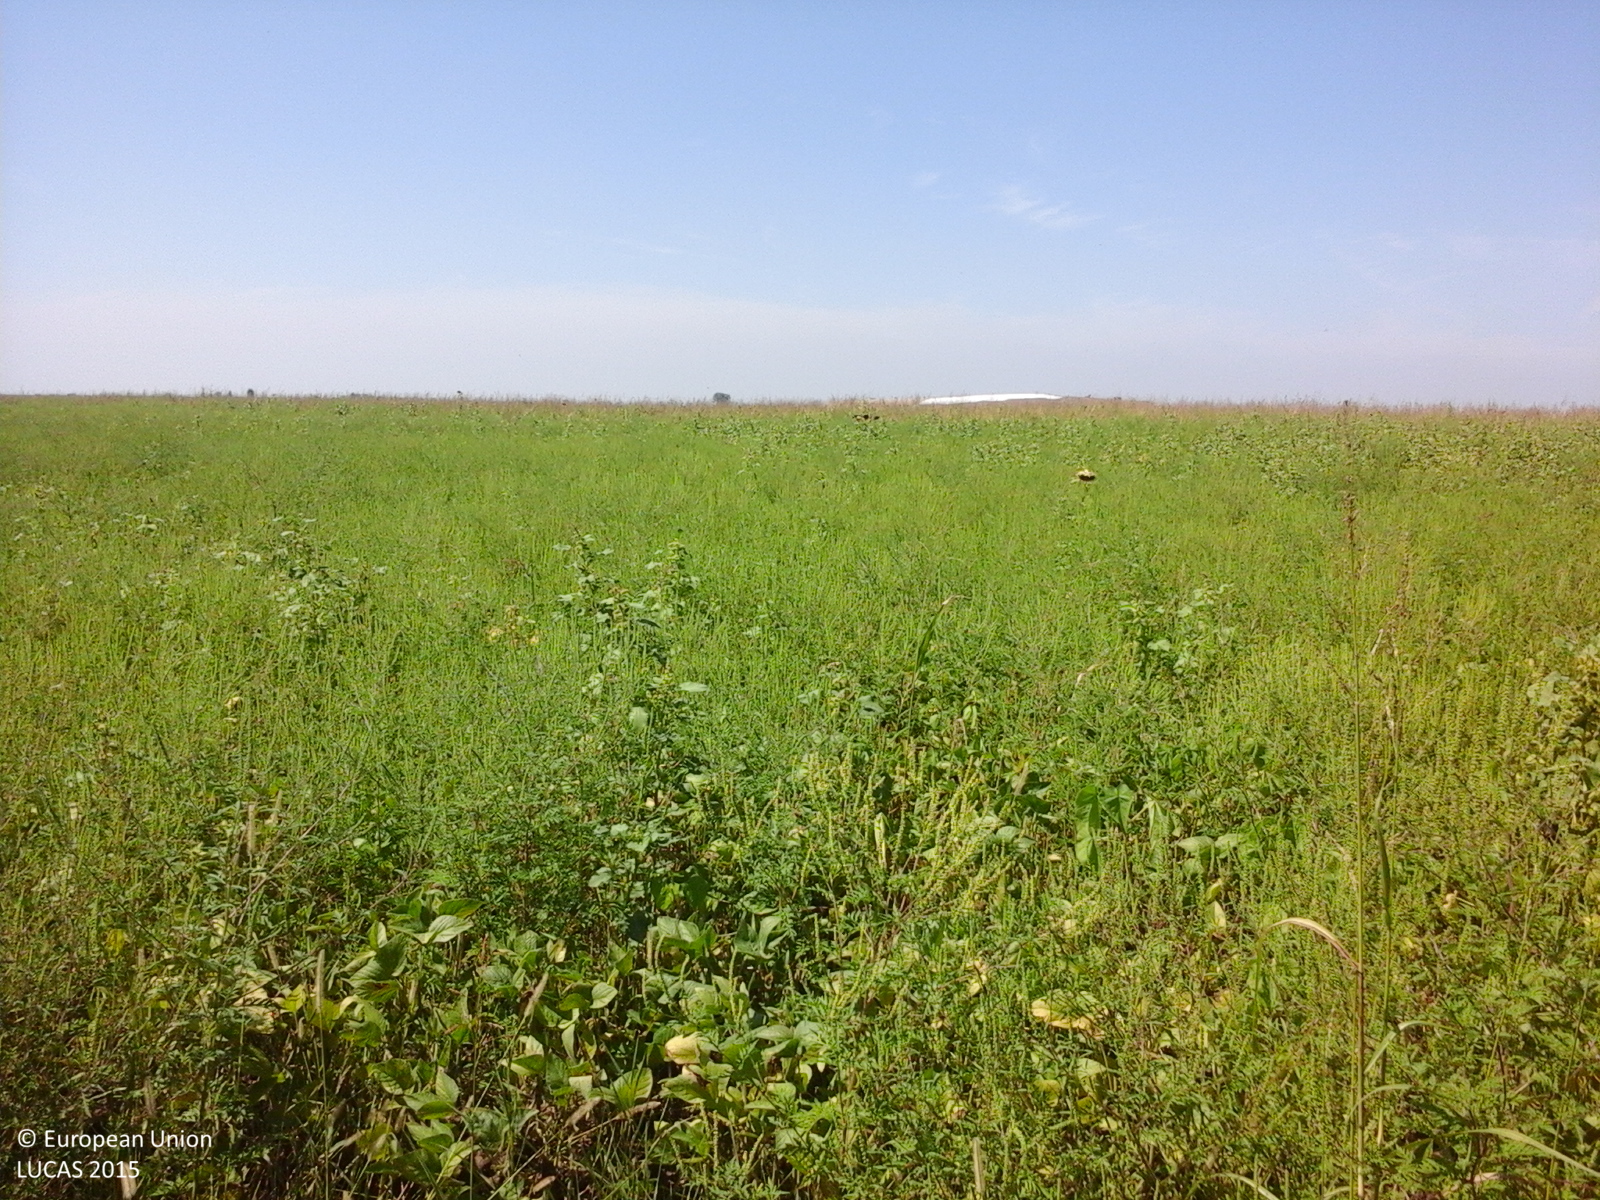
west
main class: Cropland
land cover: Soya
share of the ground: > 75 %
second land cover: Spontaneously vegetated surfaces
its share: > 75 %
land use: Agriculture (excluding fallow land and kitchen gardens)
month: August
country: RO
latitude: 45.6718
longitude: 21.1847
